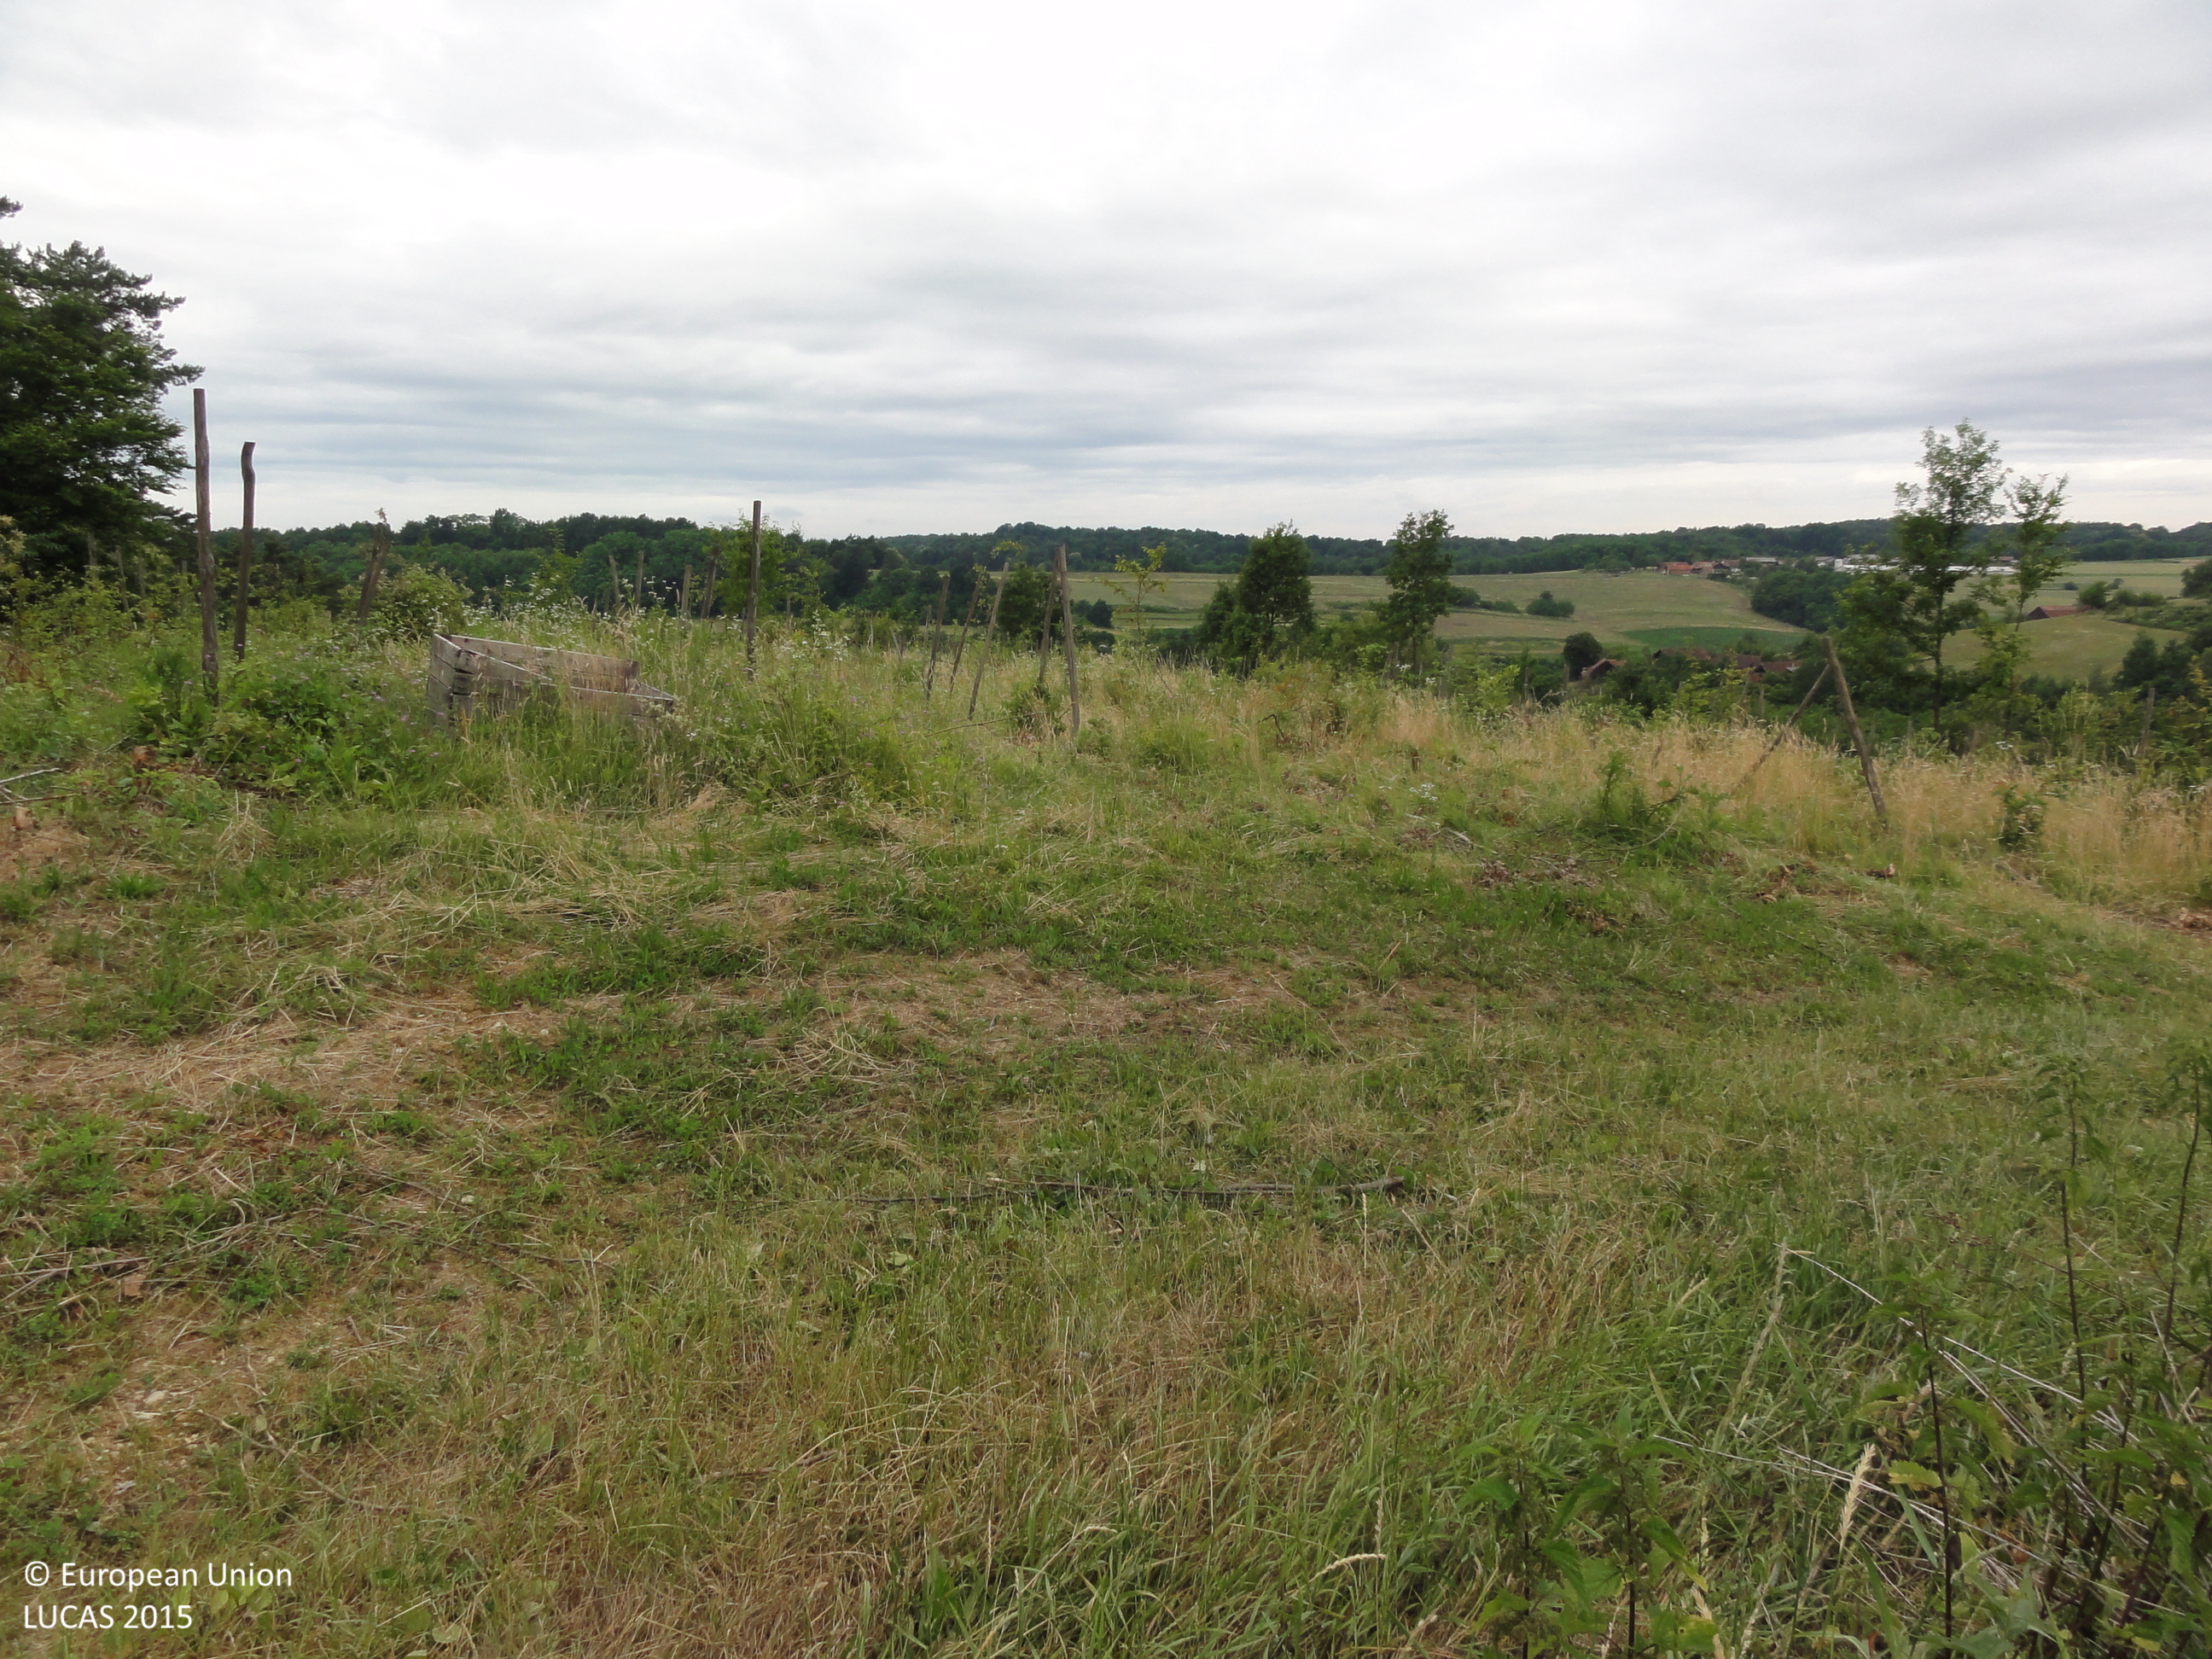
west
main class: Grassland
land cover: Spontaneously vegetated surfaces
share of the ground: > 75 %
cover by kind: herbaceous plants 100 %
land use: Abandoned areas
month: June
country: SI
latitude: 46.7676
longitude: 16.1947
